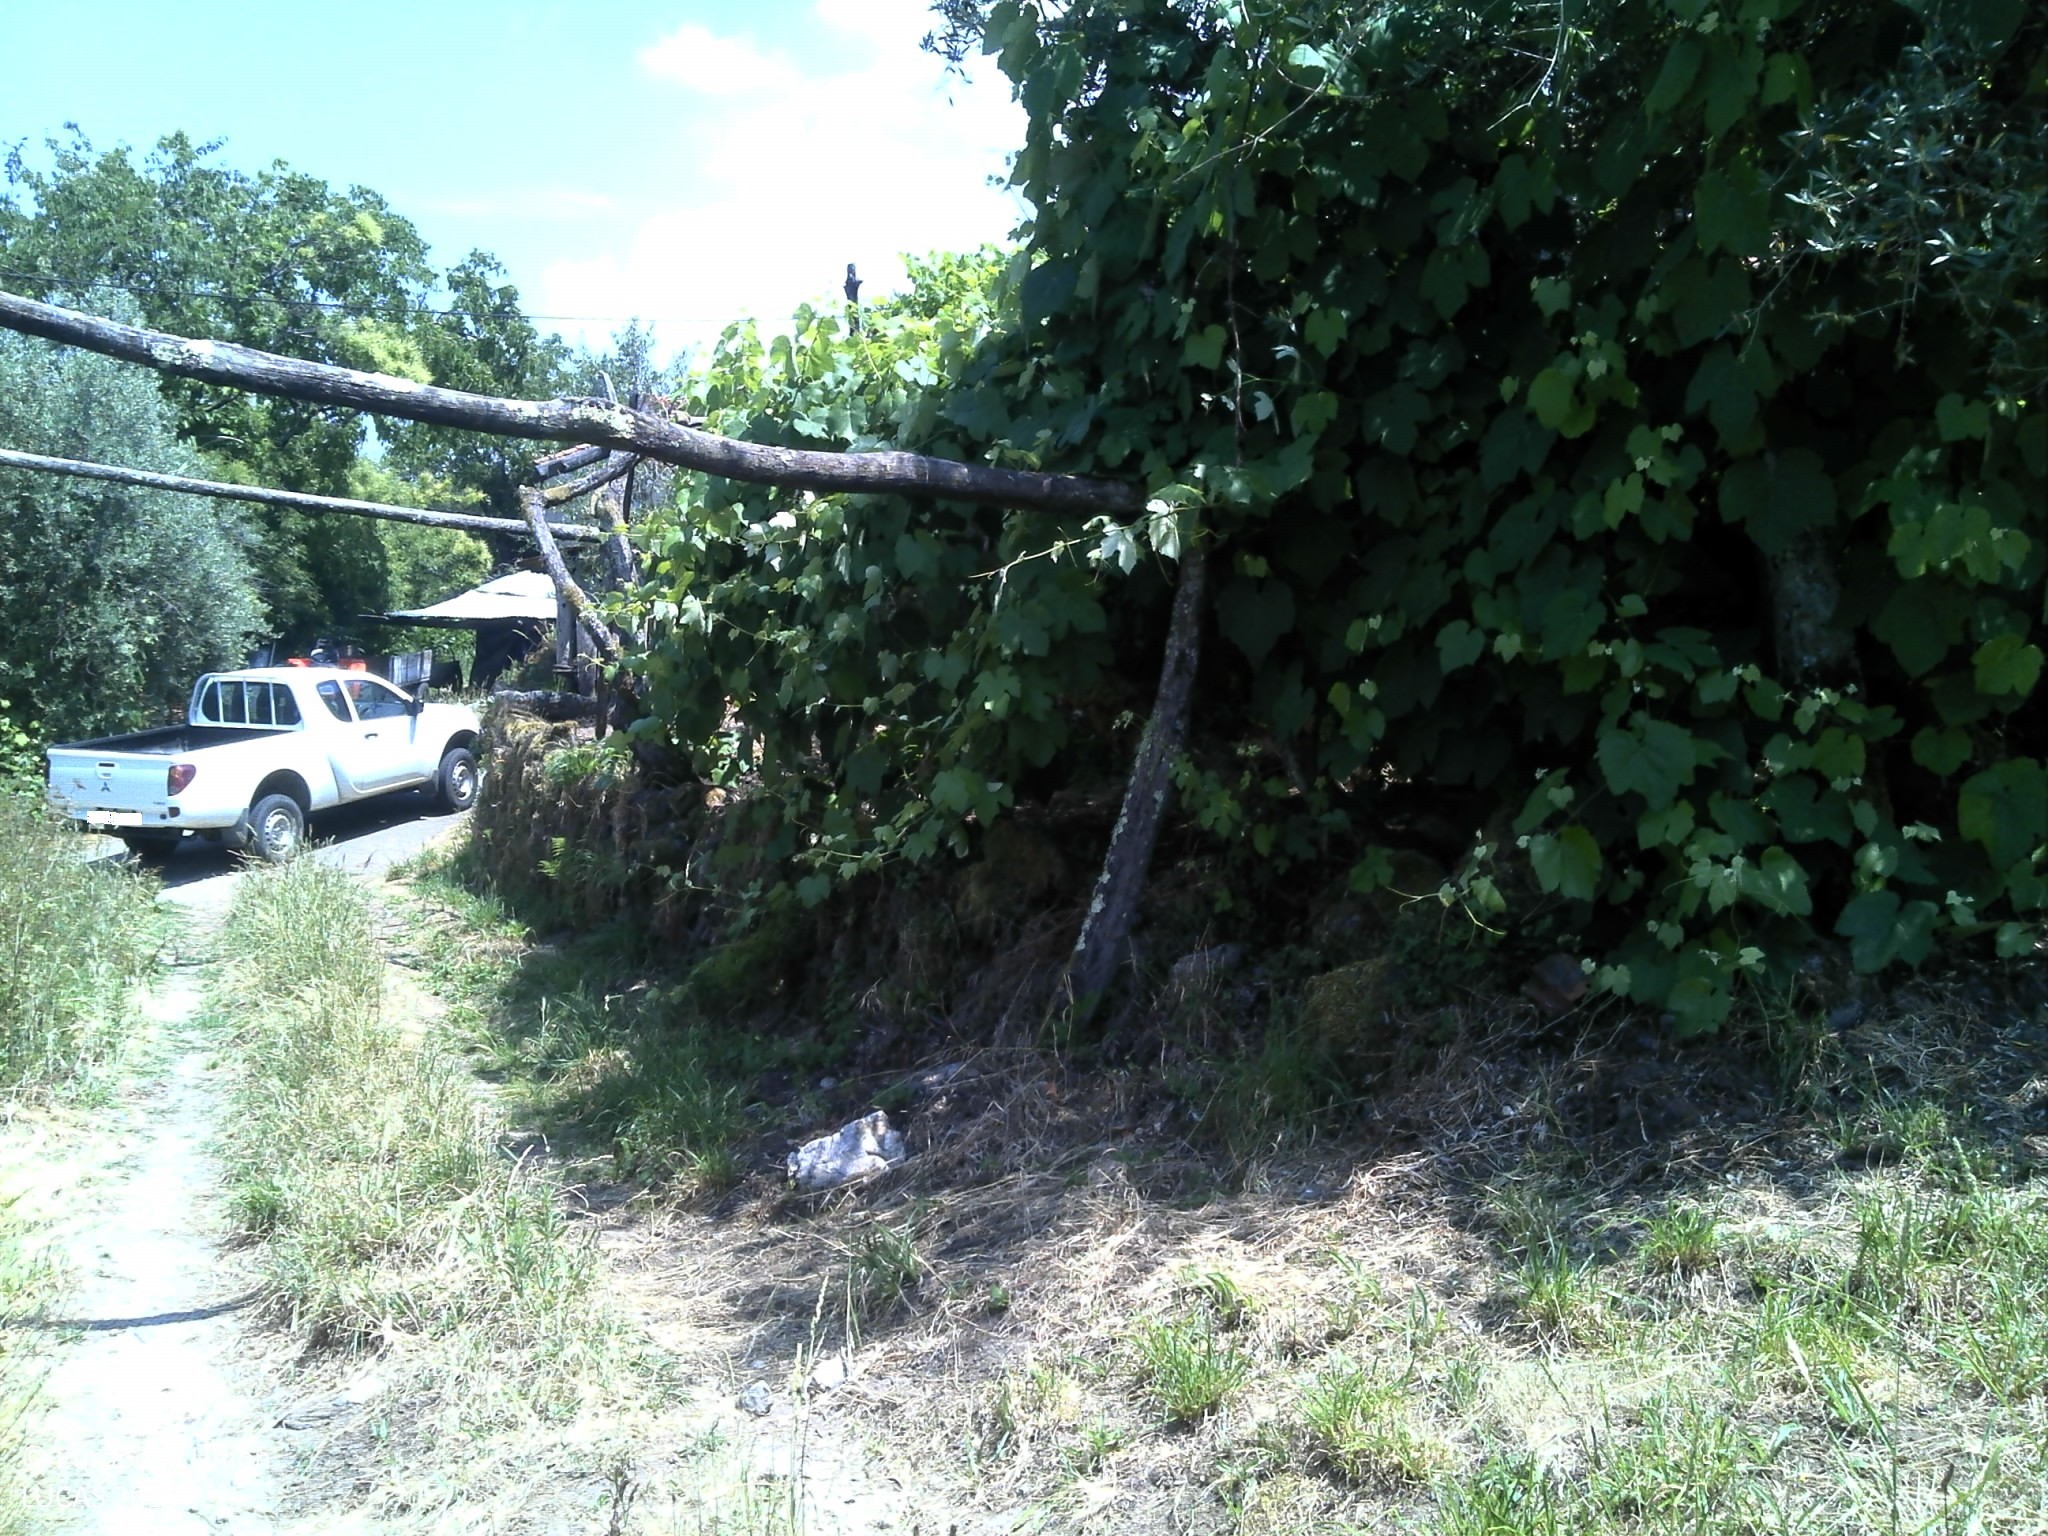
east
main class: Cropland
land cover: Vineyards
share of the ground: 25 - 50 %
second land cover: Grassland without tree/shrub cover
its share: 25 - 50 %
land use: Agriculture (excluding fallow land and kitchen gardens)
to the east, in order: Vineyards; Grassland without tree/shrub cover; Artificial constructions in urban areas; Vineyards; Electric lines; Maize; Other root crops; Single bushes/trees; Vineyards; Maize; Dry stone walls; Tracks; Dry stone walls; Vineyards; Spontaneously vegetated surfaces; Vineyards; Dry stone walls; Spontaneously vegetated surfaces; Vineyards; Spontaneously vegetated surfaces; Vineyards; Spontaneously vegetated surfaces; Broadleaved woodland
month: June
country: PT
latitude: 40.7144
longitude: -8.2825
